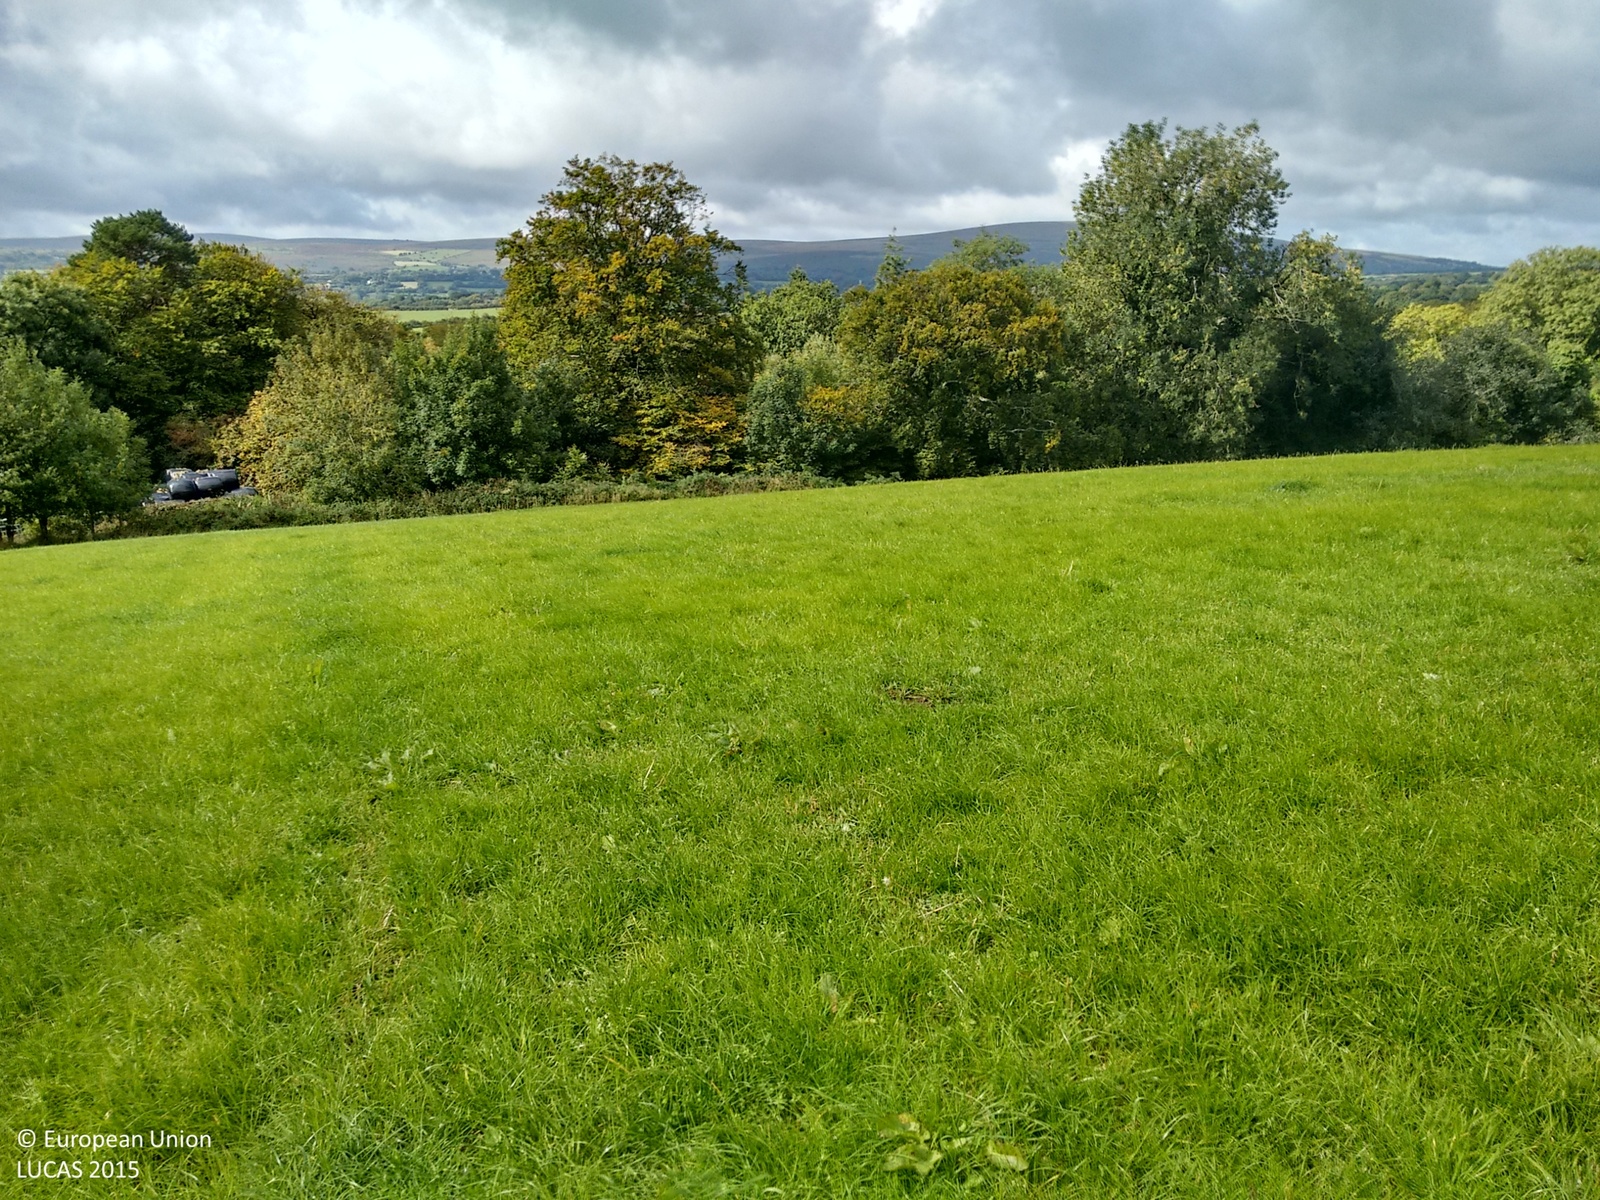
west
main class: Grassland
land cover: Grassland without tree/shrub cover
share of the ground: > 75 %
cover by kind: herbaceous plants 100 %
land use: Agriculture (excluding fallow land and kitchen gardens)
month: September
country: GB
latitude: 50.7037
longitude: -3.8395
